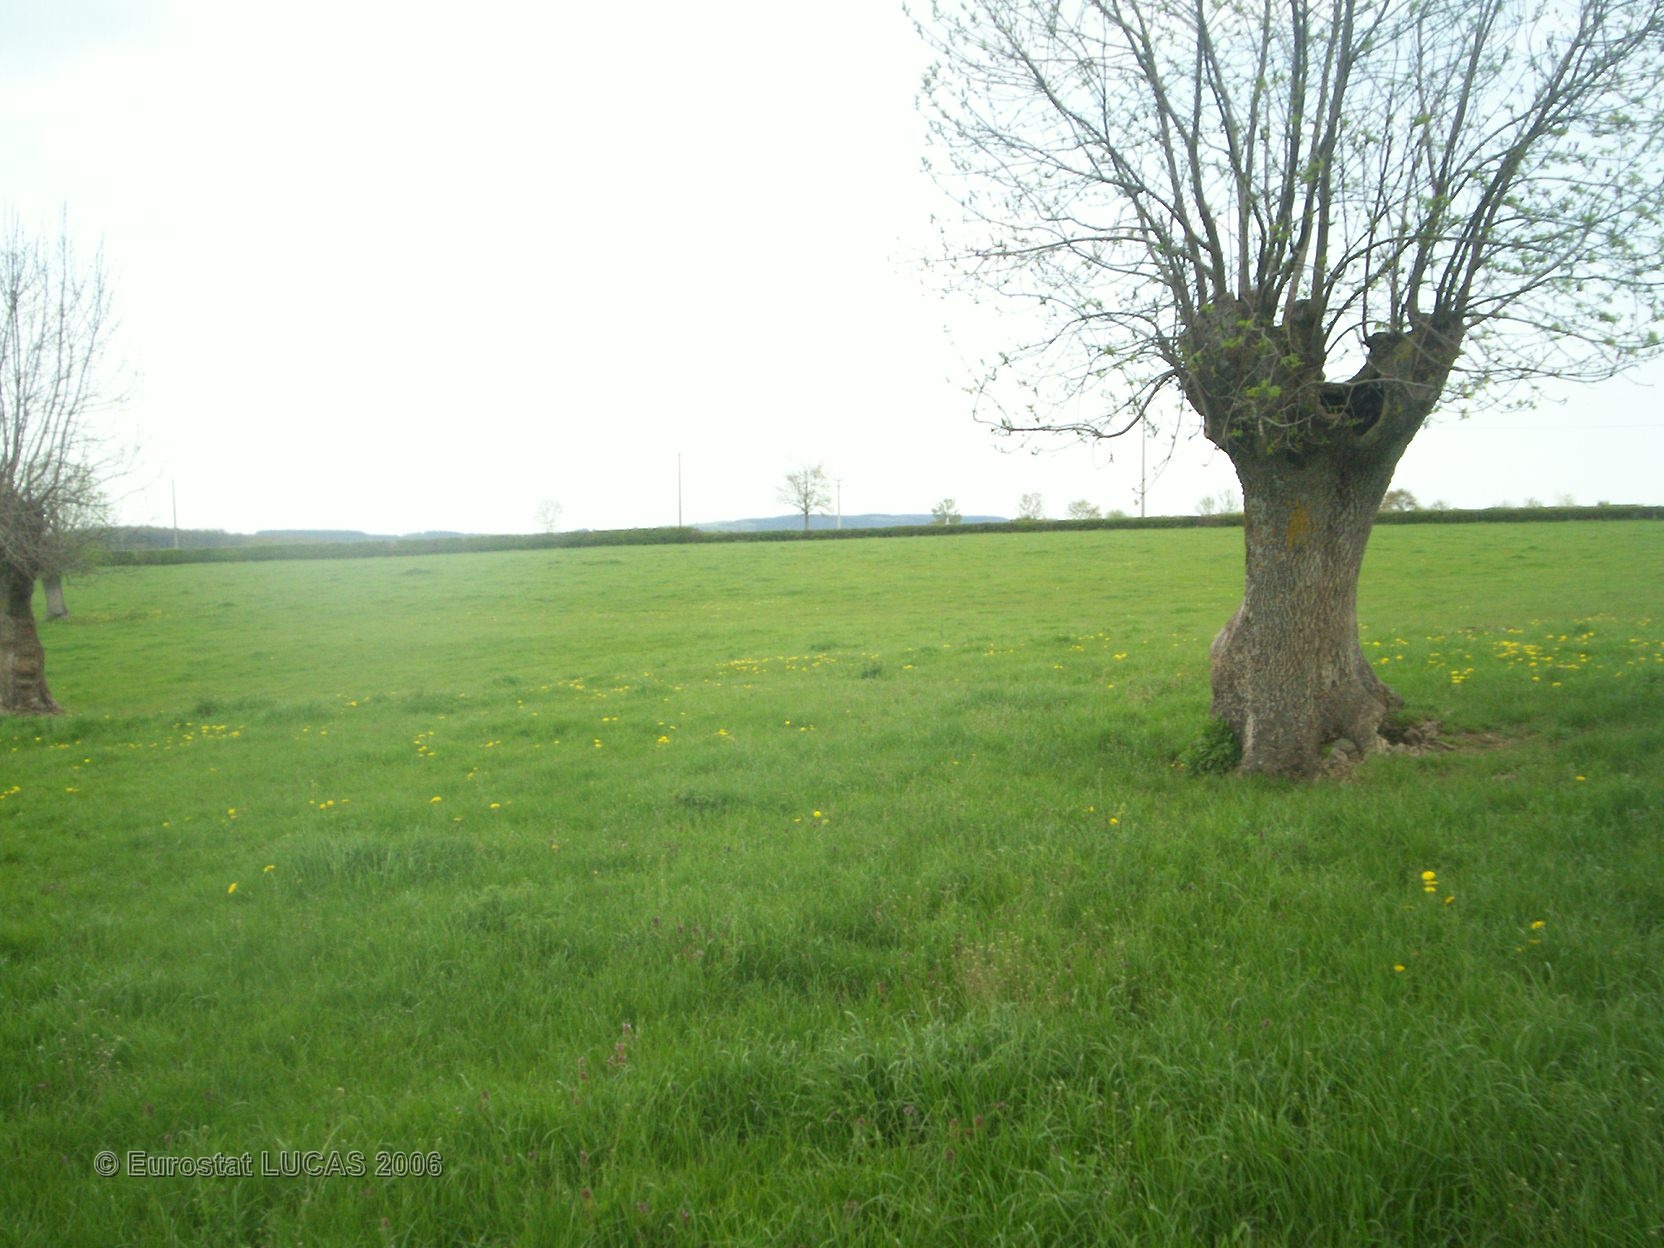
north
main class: Grassland
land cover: Grassland with sparse tree/shrub cover
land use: Agriculture (excluding fallow land and kitchen gardens)
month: May
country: FR
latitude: 46.4184
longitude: 3.1151
